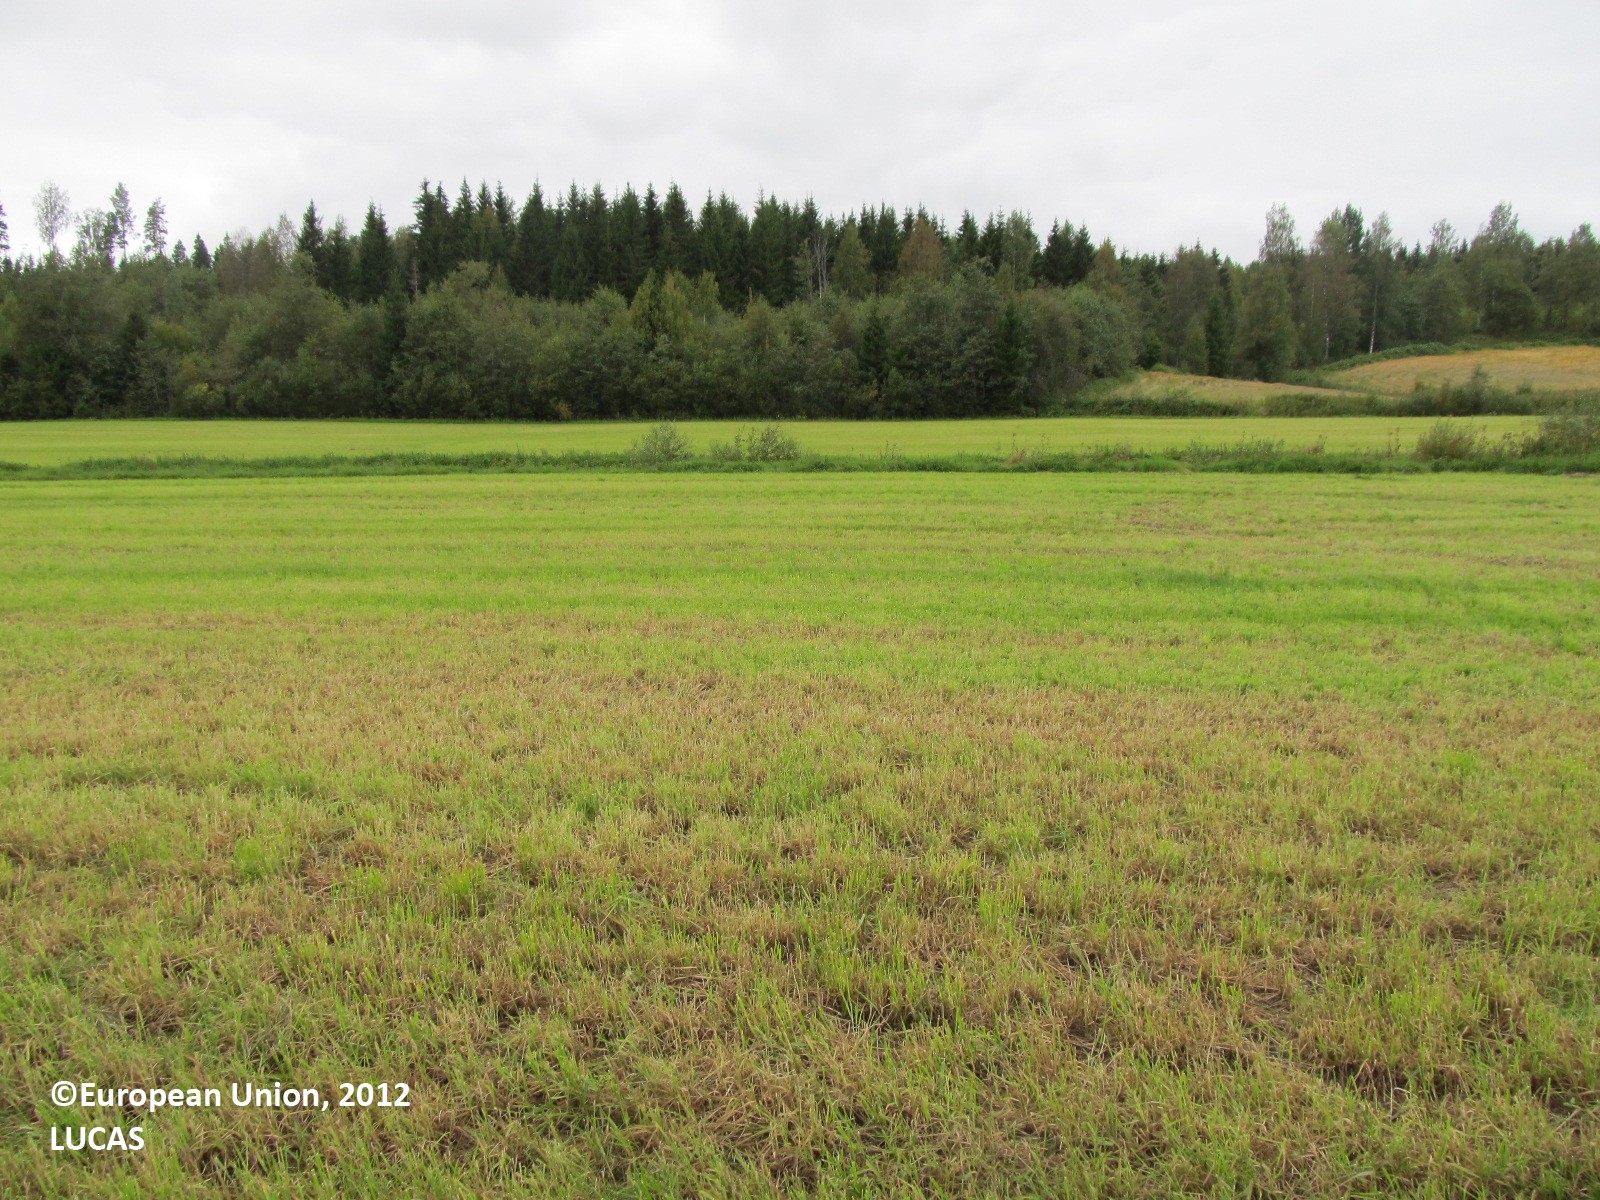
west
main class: Cropland
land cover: Temporary grasslands
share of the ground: 50 - 75 %
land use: Agriculture (excluding fallow land and kitchen gardens)
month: August
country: FI
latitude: 63.1757
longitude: 27.6232
